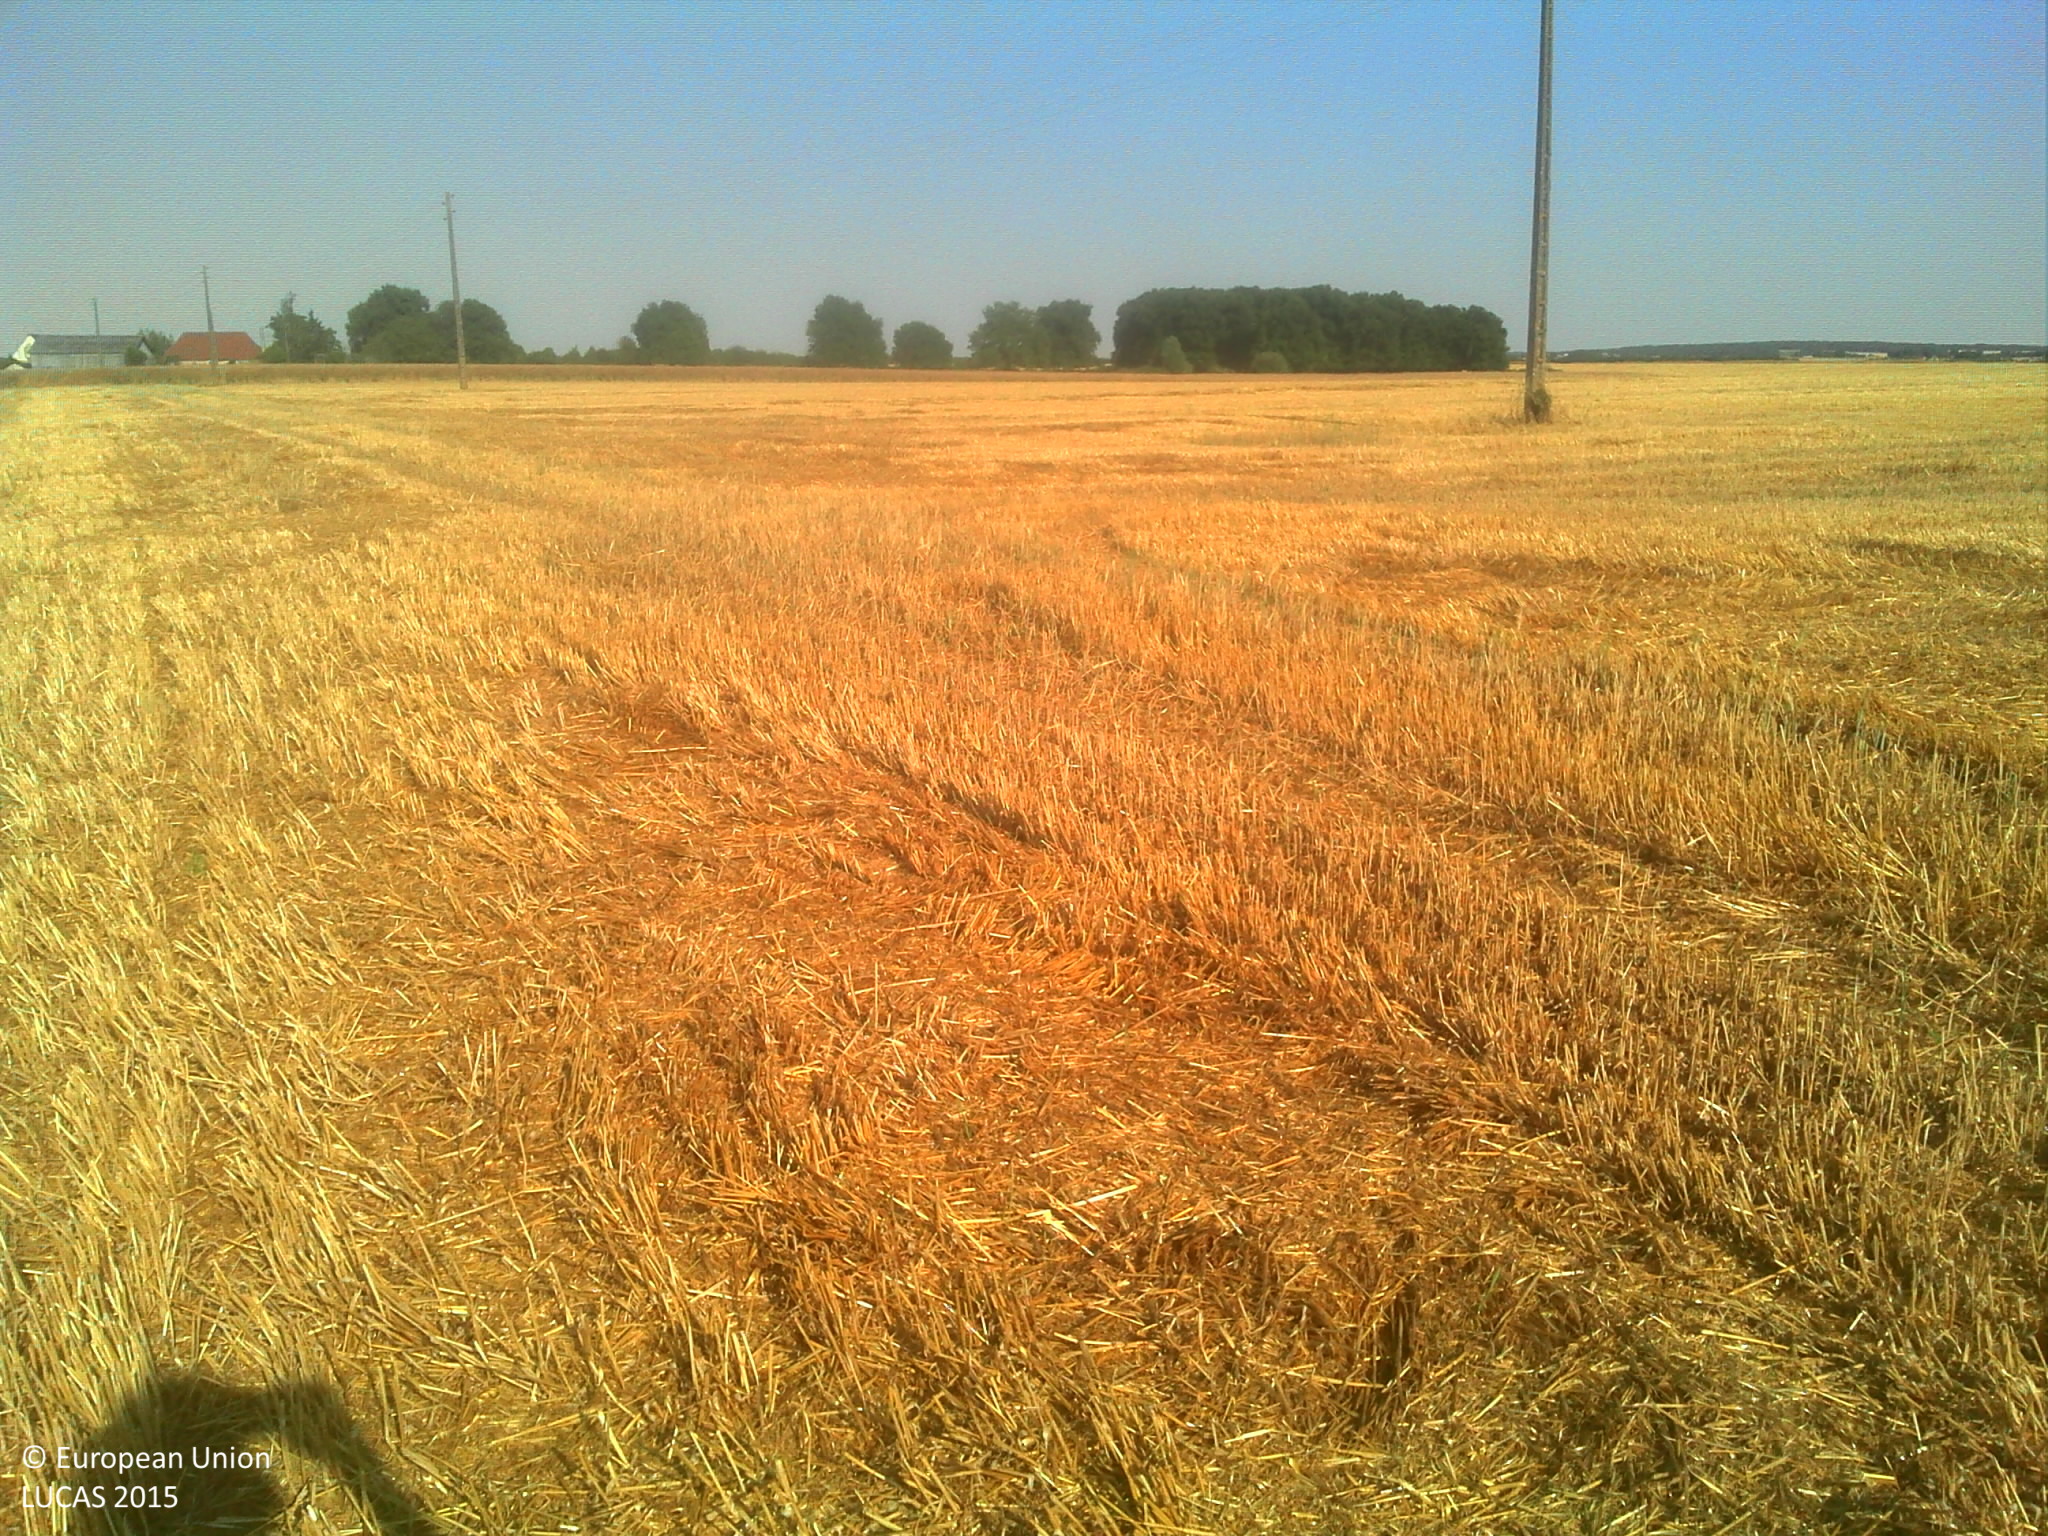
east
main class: Cropland
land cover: Common wheat
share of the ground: > 75 %
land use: Agriculture (excluding fallow land and kitchen gardens)
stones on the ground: < 10 %
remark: Harvested field
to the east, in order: Common wheat; Rape and turnip rape
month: July
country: FR
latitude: 47.6998
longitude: 0.6645
